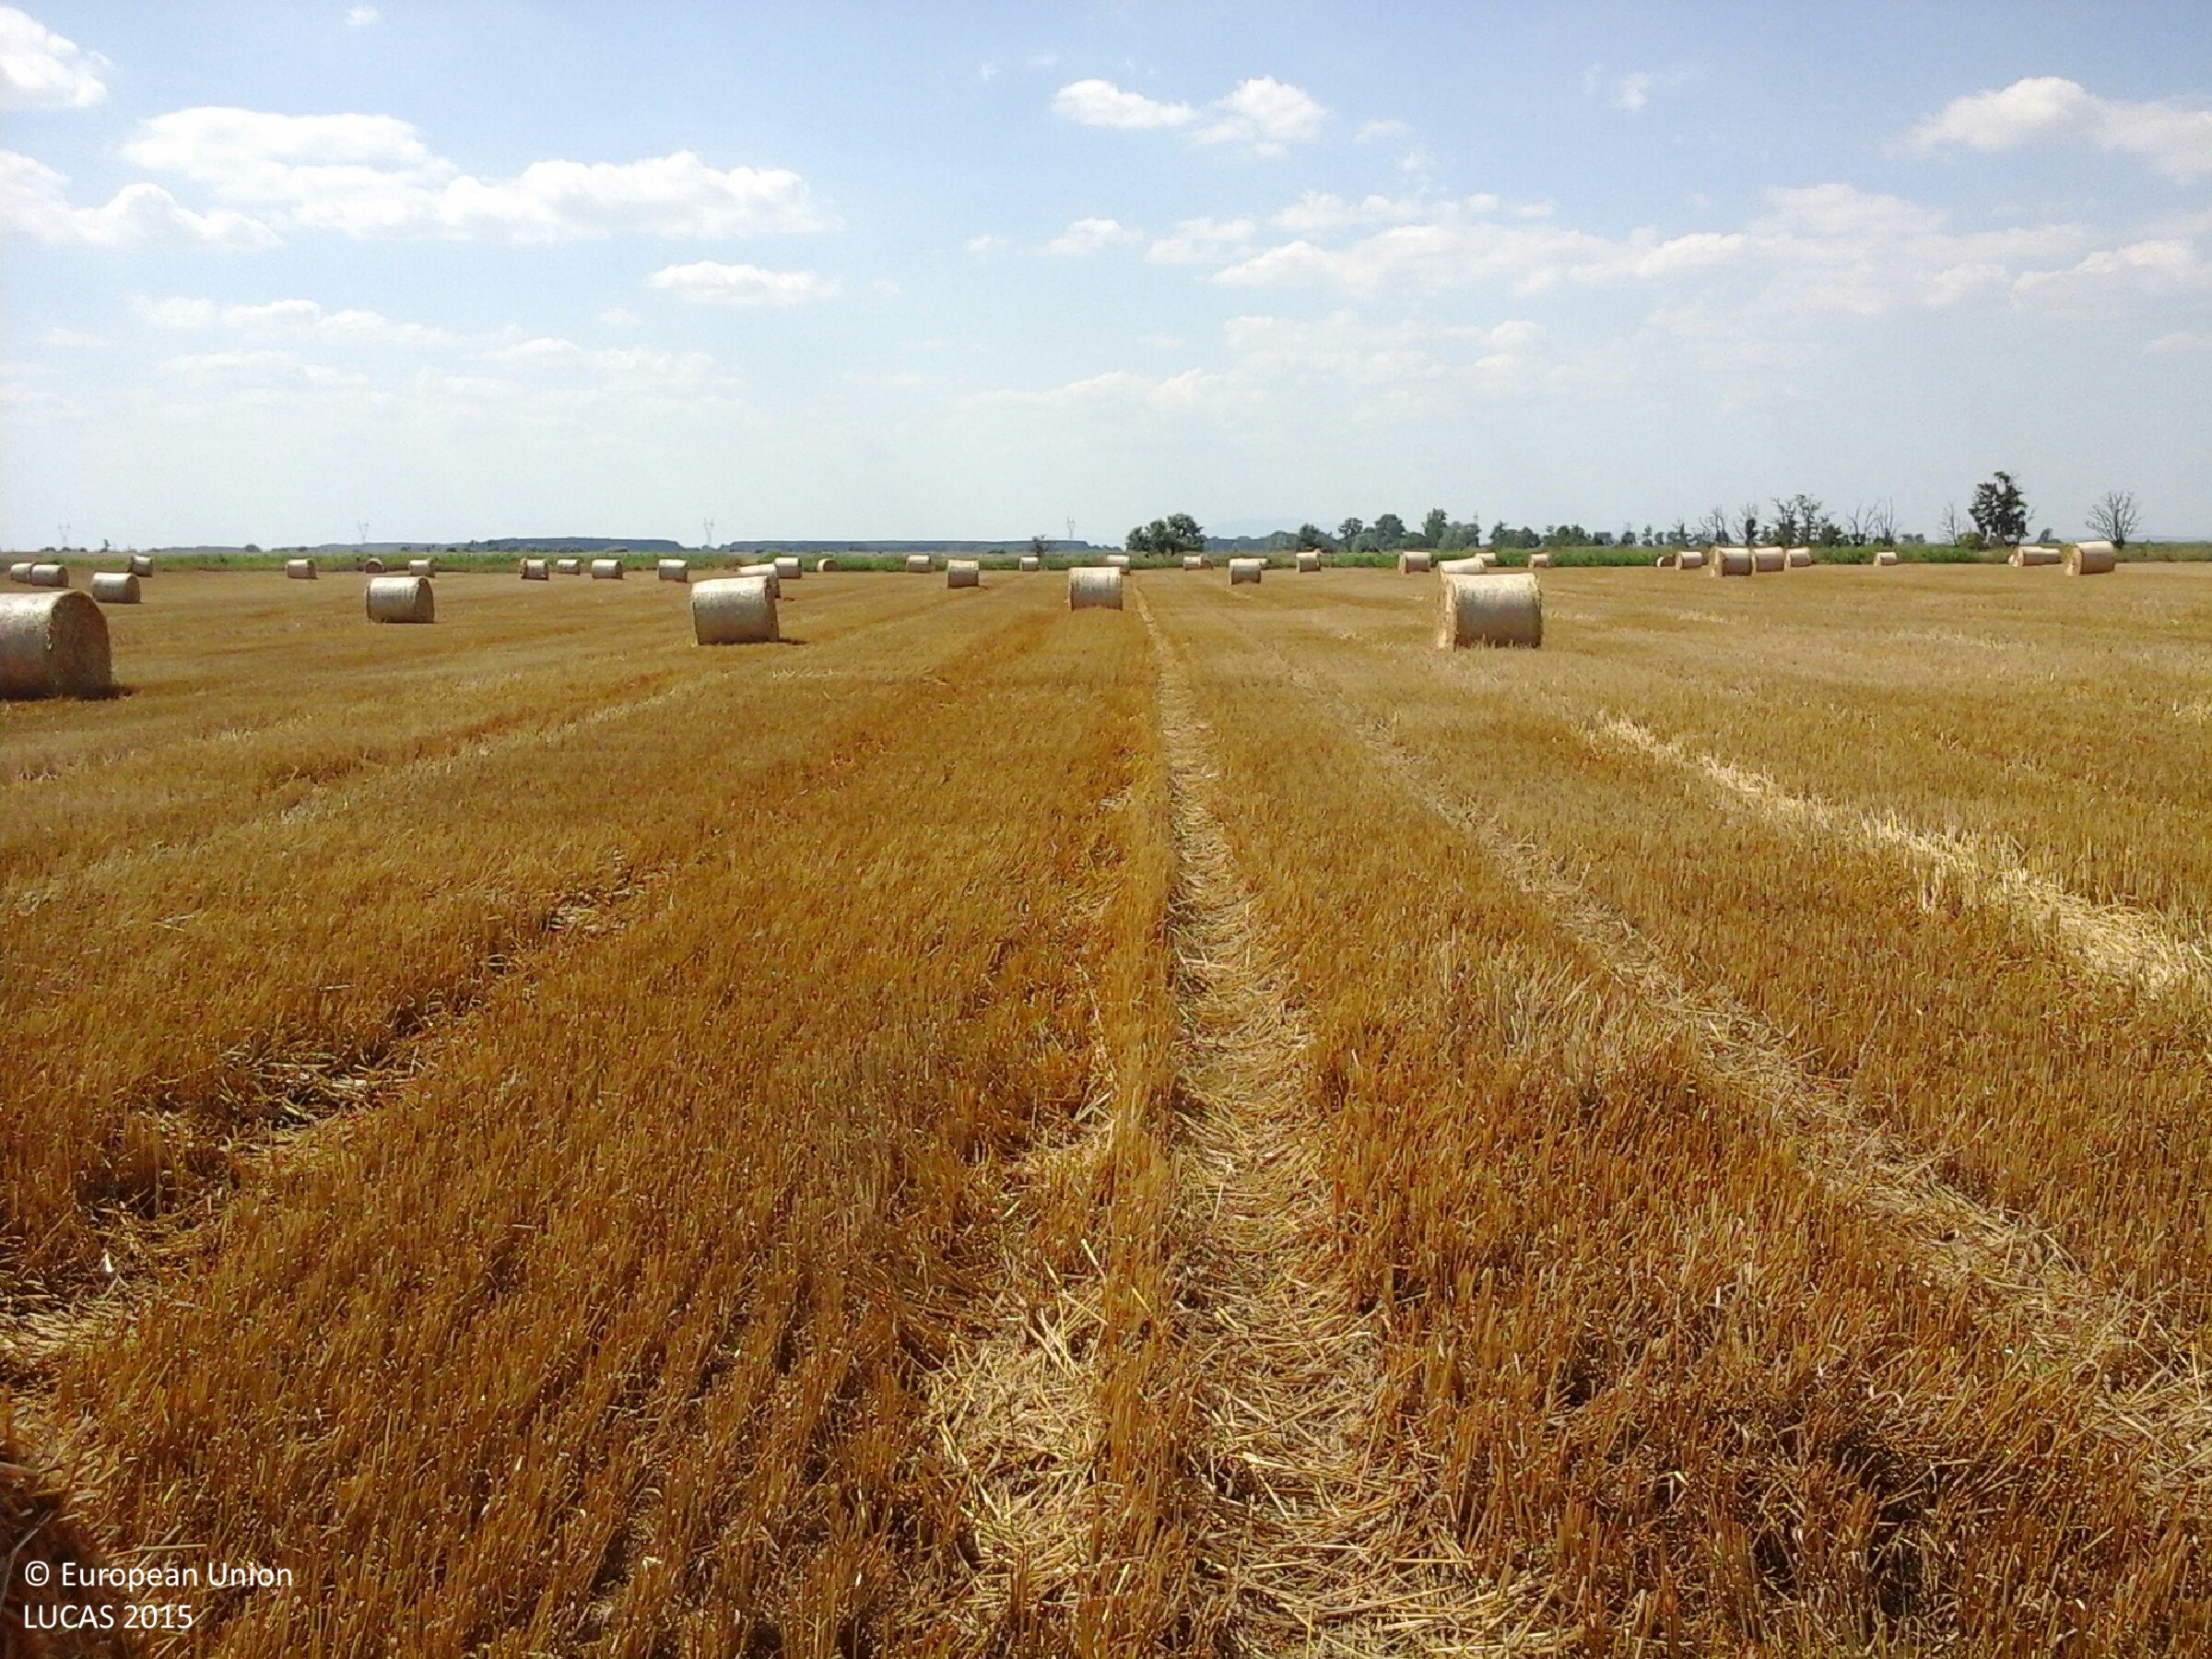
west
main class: Cropland
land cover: Common wheat
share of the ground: 50 - 75 %
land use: Agriculture (excluding fallow land and kitchen gardens)
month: July
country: HU
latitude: 47.6574
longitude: 20.5914
